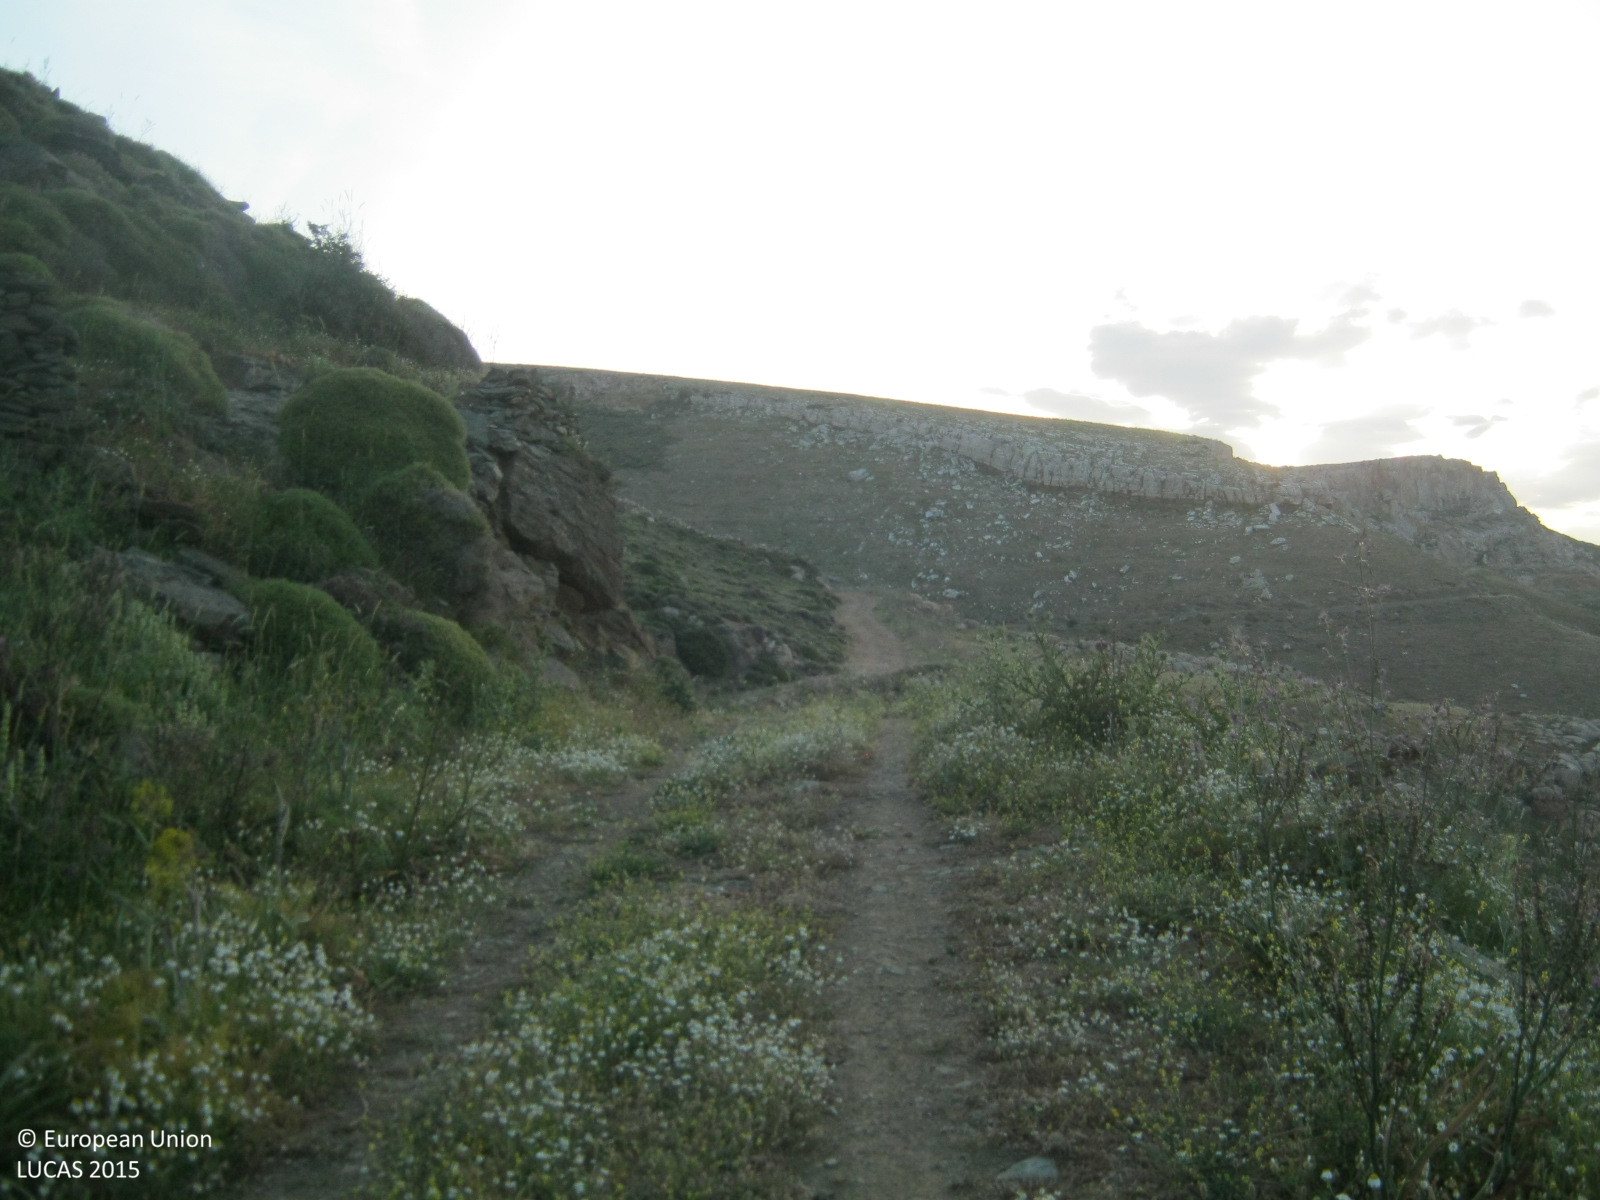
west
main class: Shrubland
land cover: Shrubland without tree cover
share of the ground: > 75 %
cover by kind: shrubs 75 %, herbaceous plants 25 %
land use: Agriculture (excluding fallow land and kitchen gardens)
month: May
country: GR
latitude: 37.6791
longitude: 24.3719
